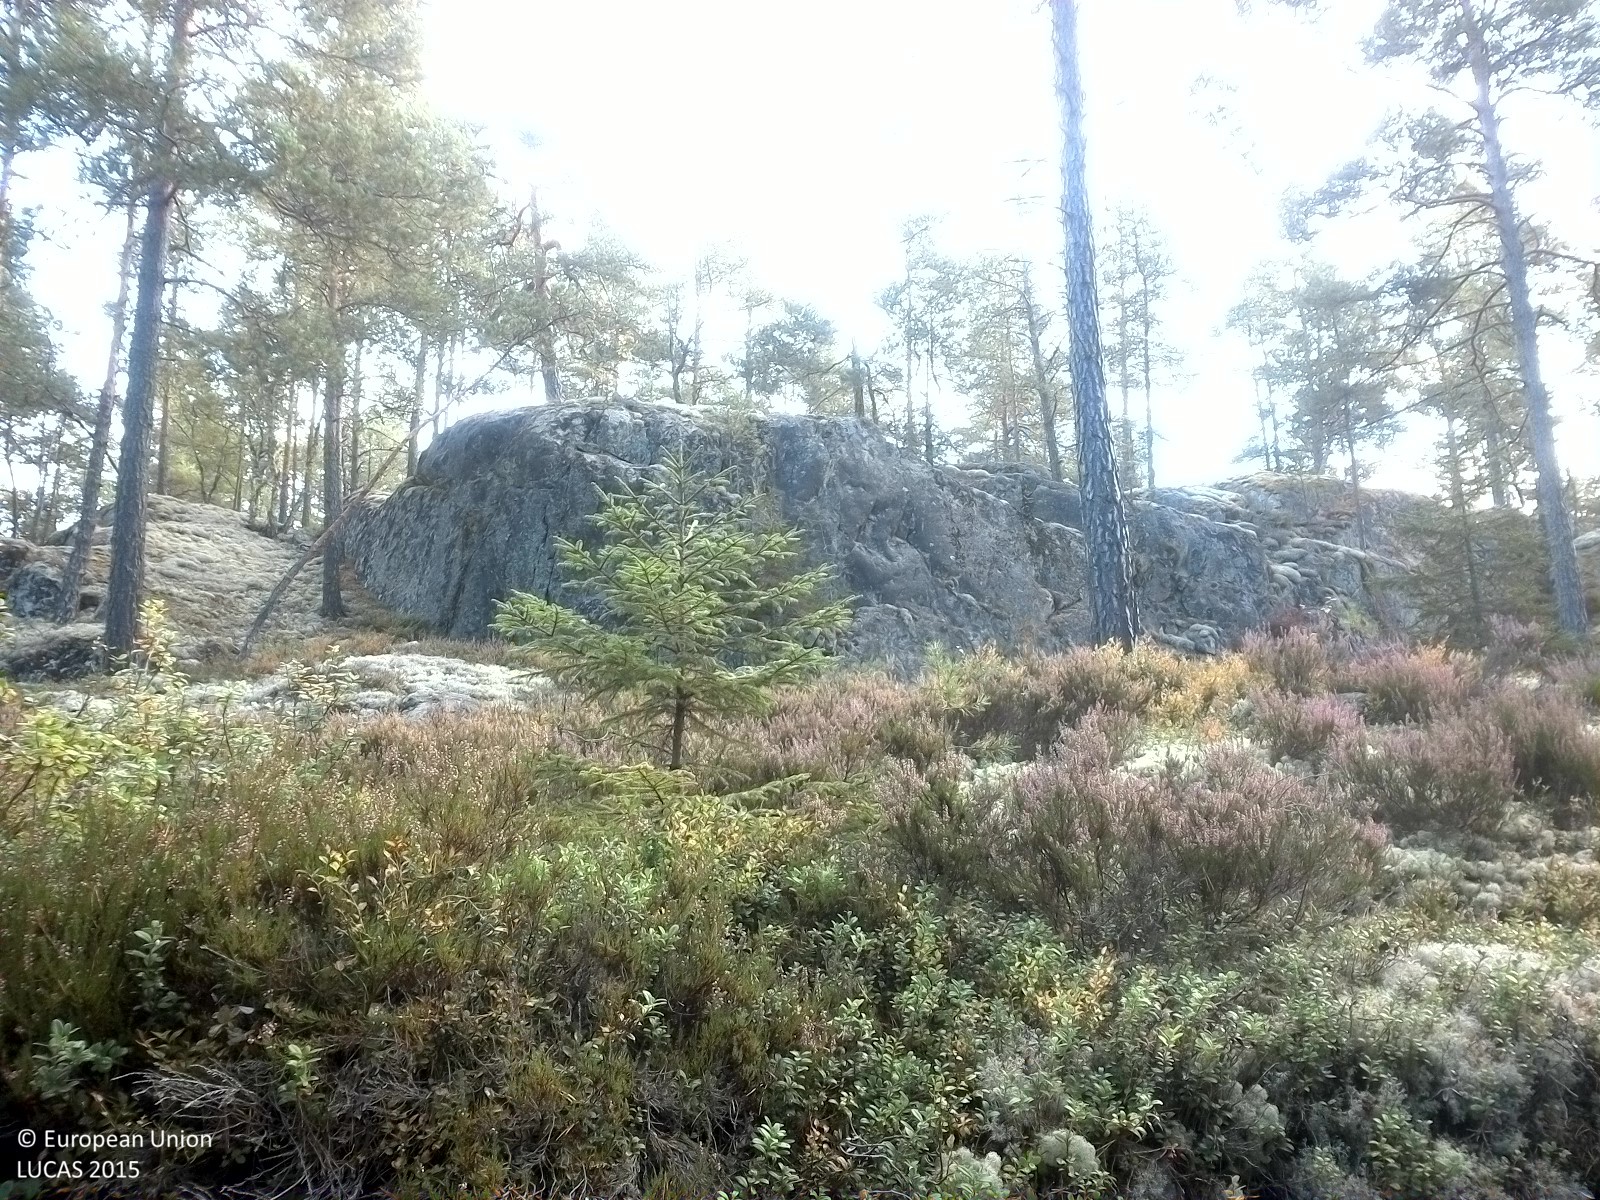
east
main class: Woodland
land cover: Pine dominated coniferous woodland
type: boreal forest
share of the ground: 10 - 25 %
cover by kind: shrubs 50 %, coniferous forest trees 20 %, lichens and mosses 20 %, herbaceous plants 10 %
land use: Forestry
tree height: > 5 m
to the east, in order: Pine dominated coniferous woodland; Shrubland with sparse tree cover; Electric lines; Shrubland with sparse tree cover; Pine dominated coniferous woodland
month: September
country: SE
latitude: 58.9611
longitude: 15.7833
